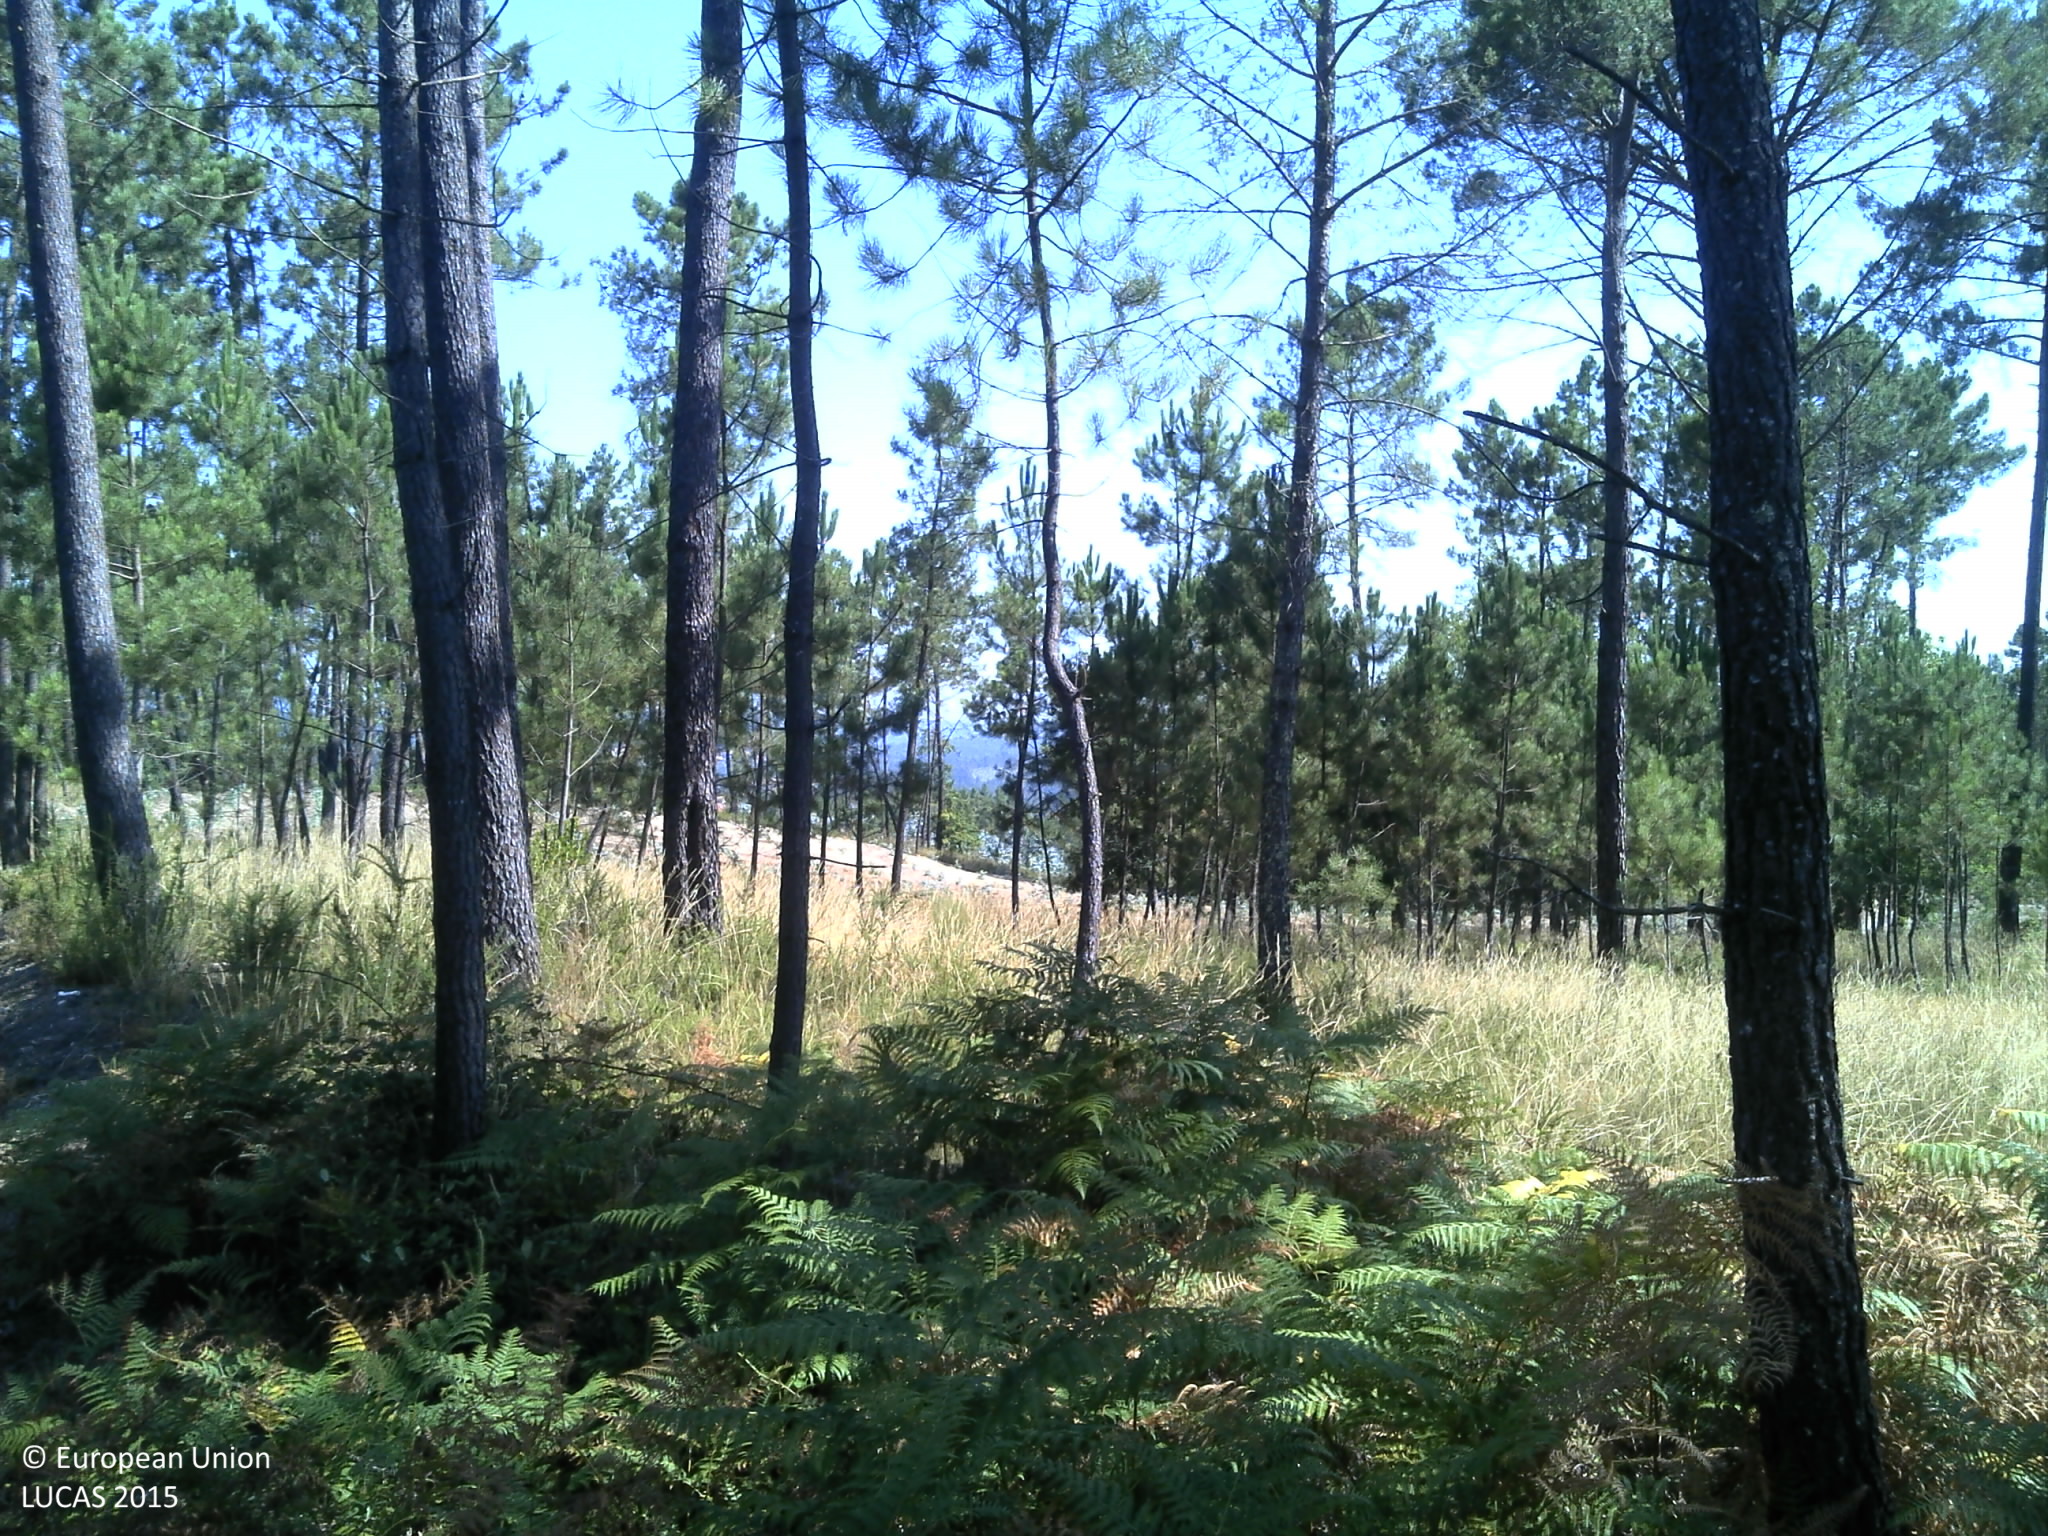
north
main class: Woodland
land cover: Pine dominated coniferous woodland
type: coniferous forest of the mediterranean region
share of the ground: 50 - 75 %
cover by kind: coniferous forest trees 60 %, shrubs 15 %, consolidated bare surface 10 %, unconsolidated bare surface 10 %, herbaceous plants 5 %
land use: Forestry
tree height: > 5 m
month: July
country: PT
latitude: 40.4294
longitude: -8.0286
